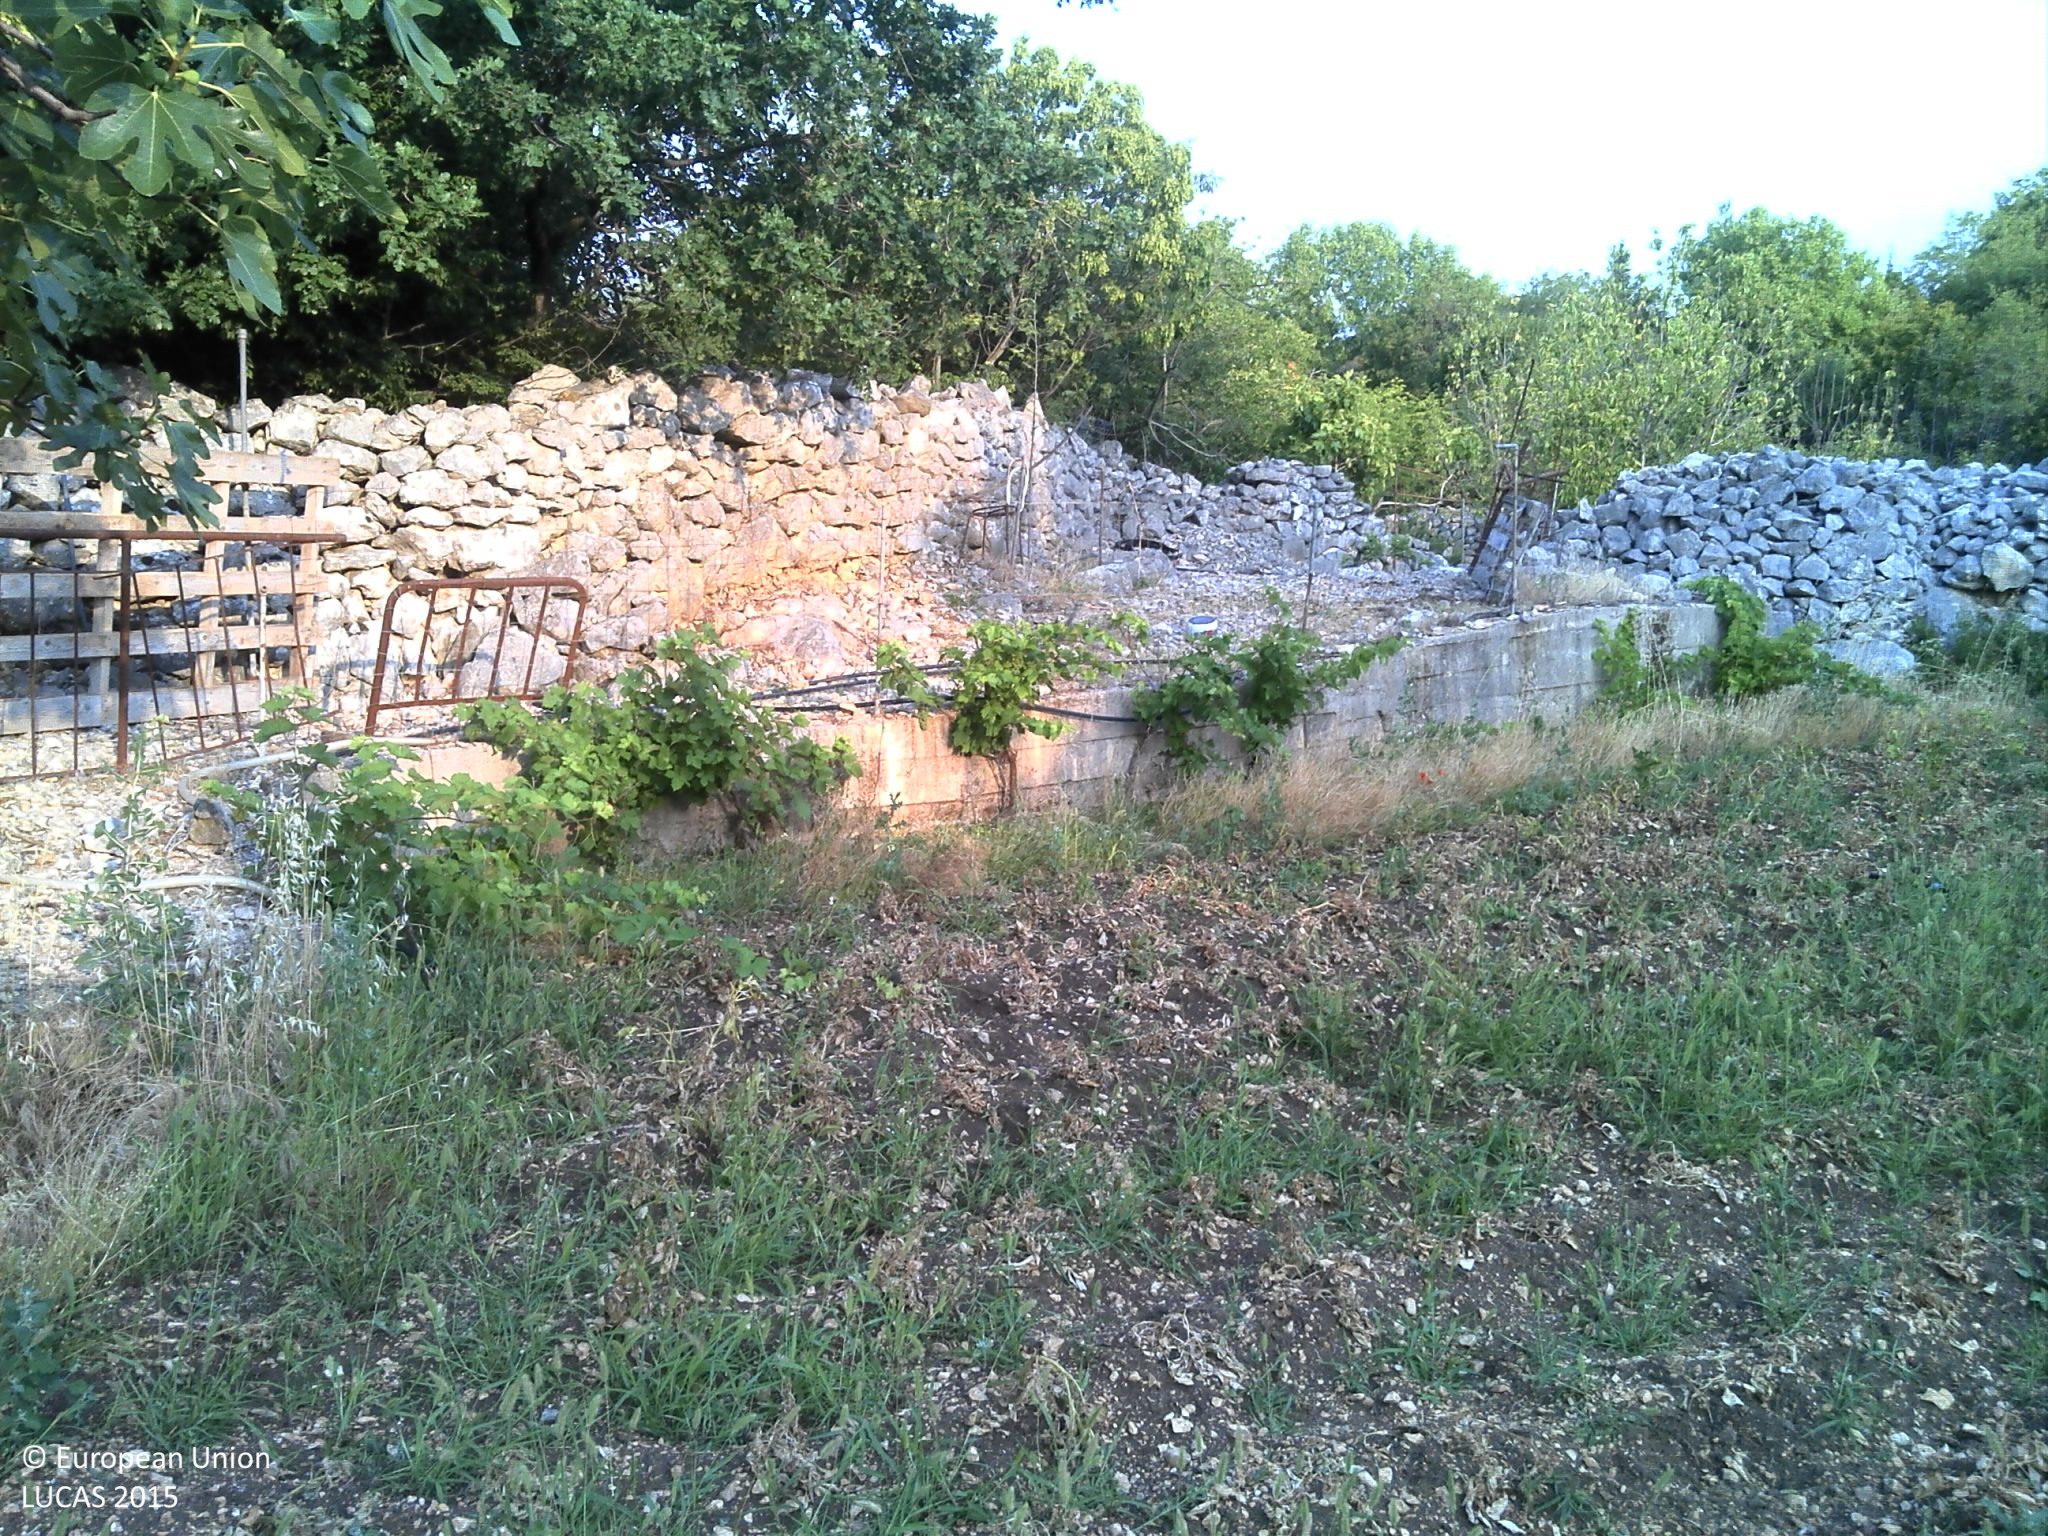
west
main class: Grassland
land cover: Grassland without tree/shrub cover
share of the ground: > 75 %
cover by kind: herbaceous plants 90 %, shrubs 5 %, consolidated bare surface 5 %
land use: Agriculture (excluding fallow land and kitchen gardens)
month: July
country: HR
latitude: 43.4331
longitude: 16.8970
